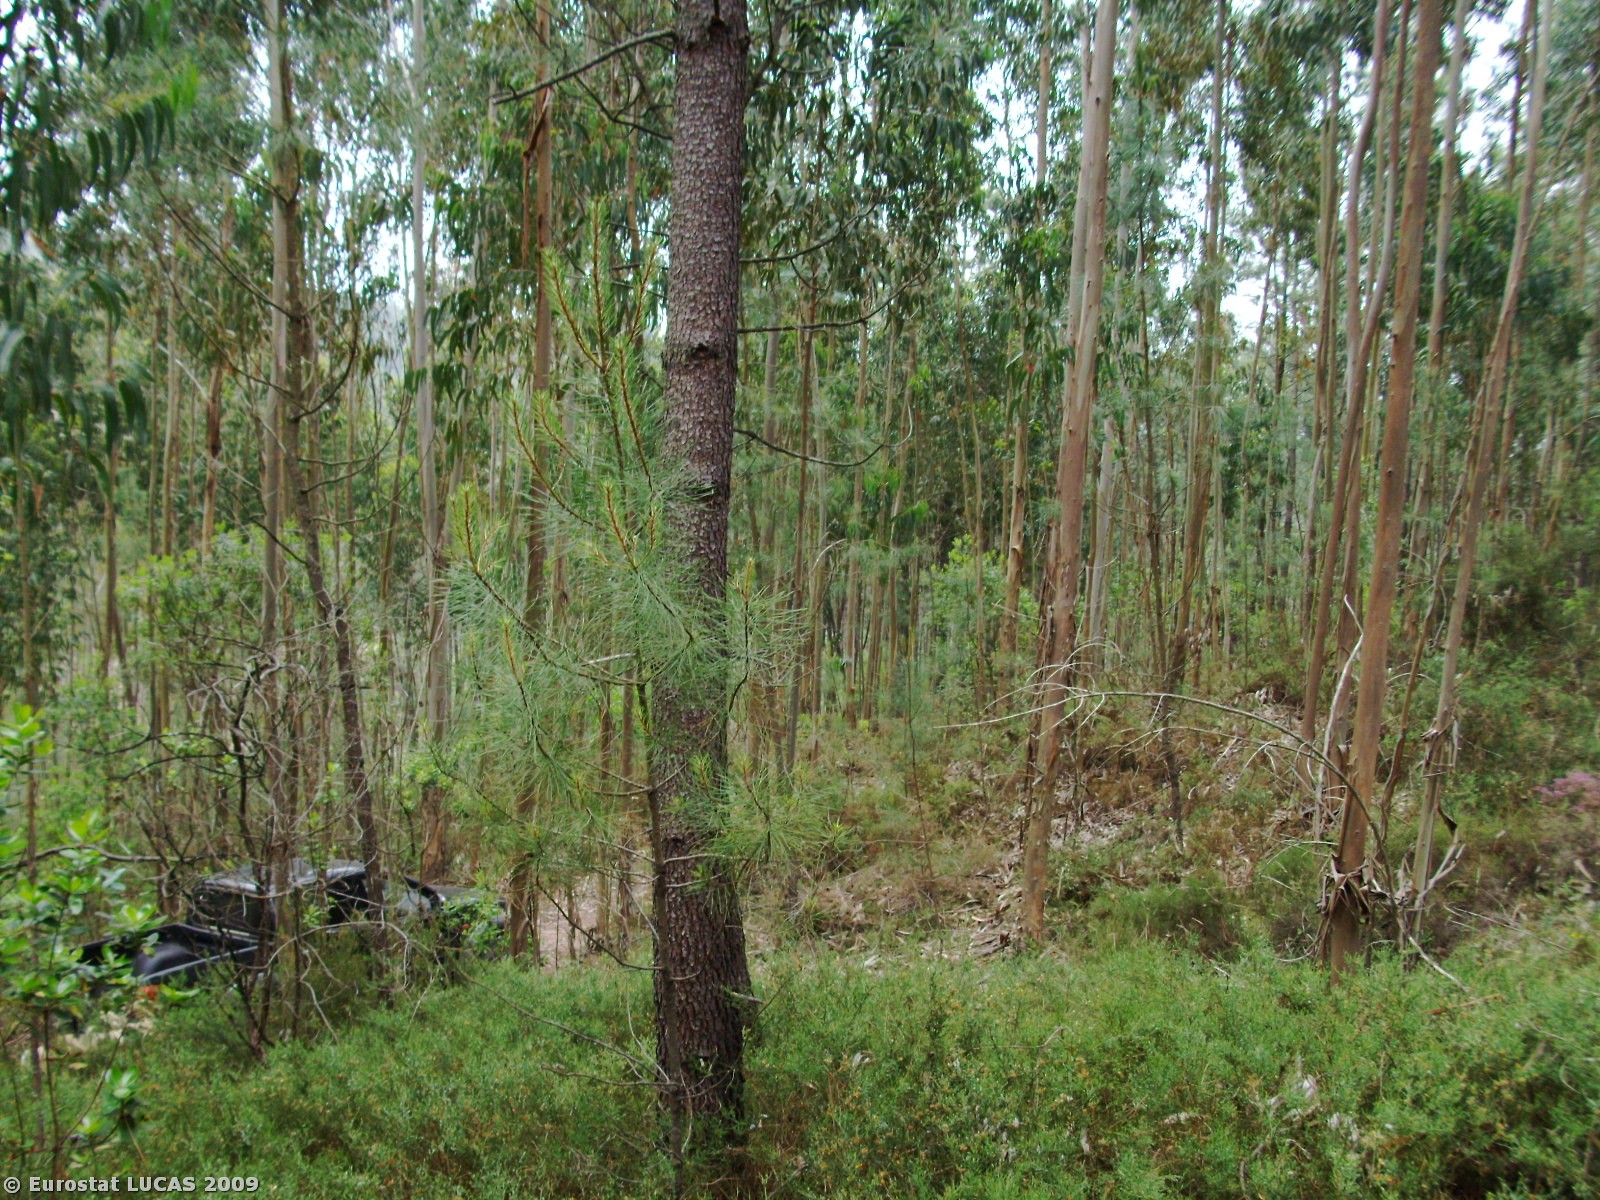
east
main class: Woodland
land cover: Mixed woodland
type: coniferous forest of the mediterranean region
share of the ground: > 75 %
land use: Forestry
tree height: > 5 m
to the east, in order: Mixed woodland; Tracks; Broadleaved woodland; Tracks; Broadleaved woodland; Rivers and streams; Abandoned hedges; Tracks; Broadleaved woodland
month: May
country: PT
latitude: 40.4171
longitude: -8.3886
